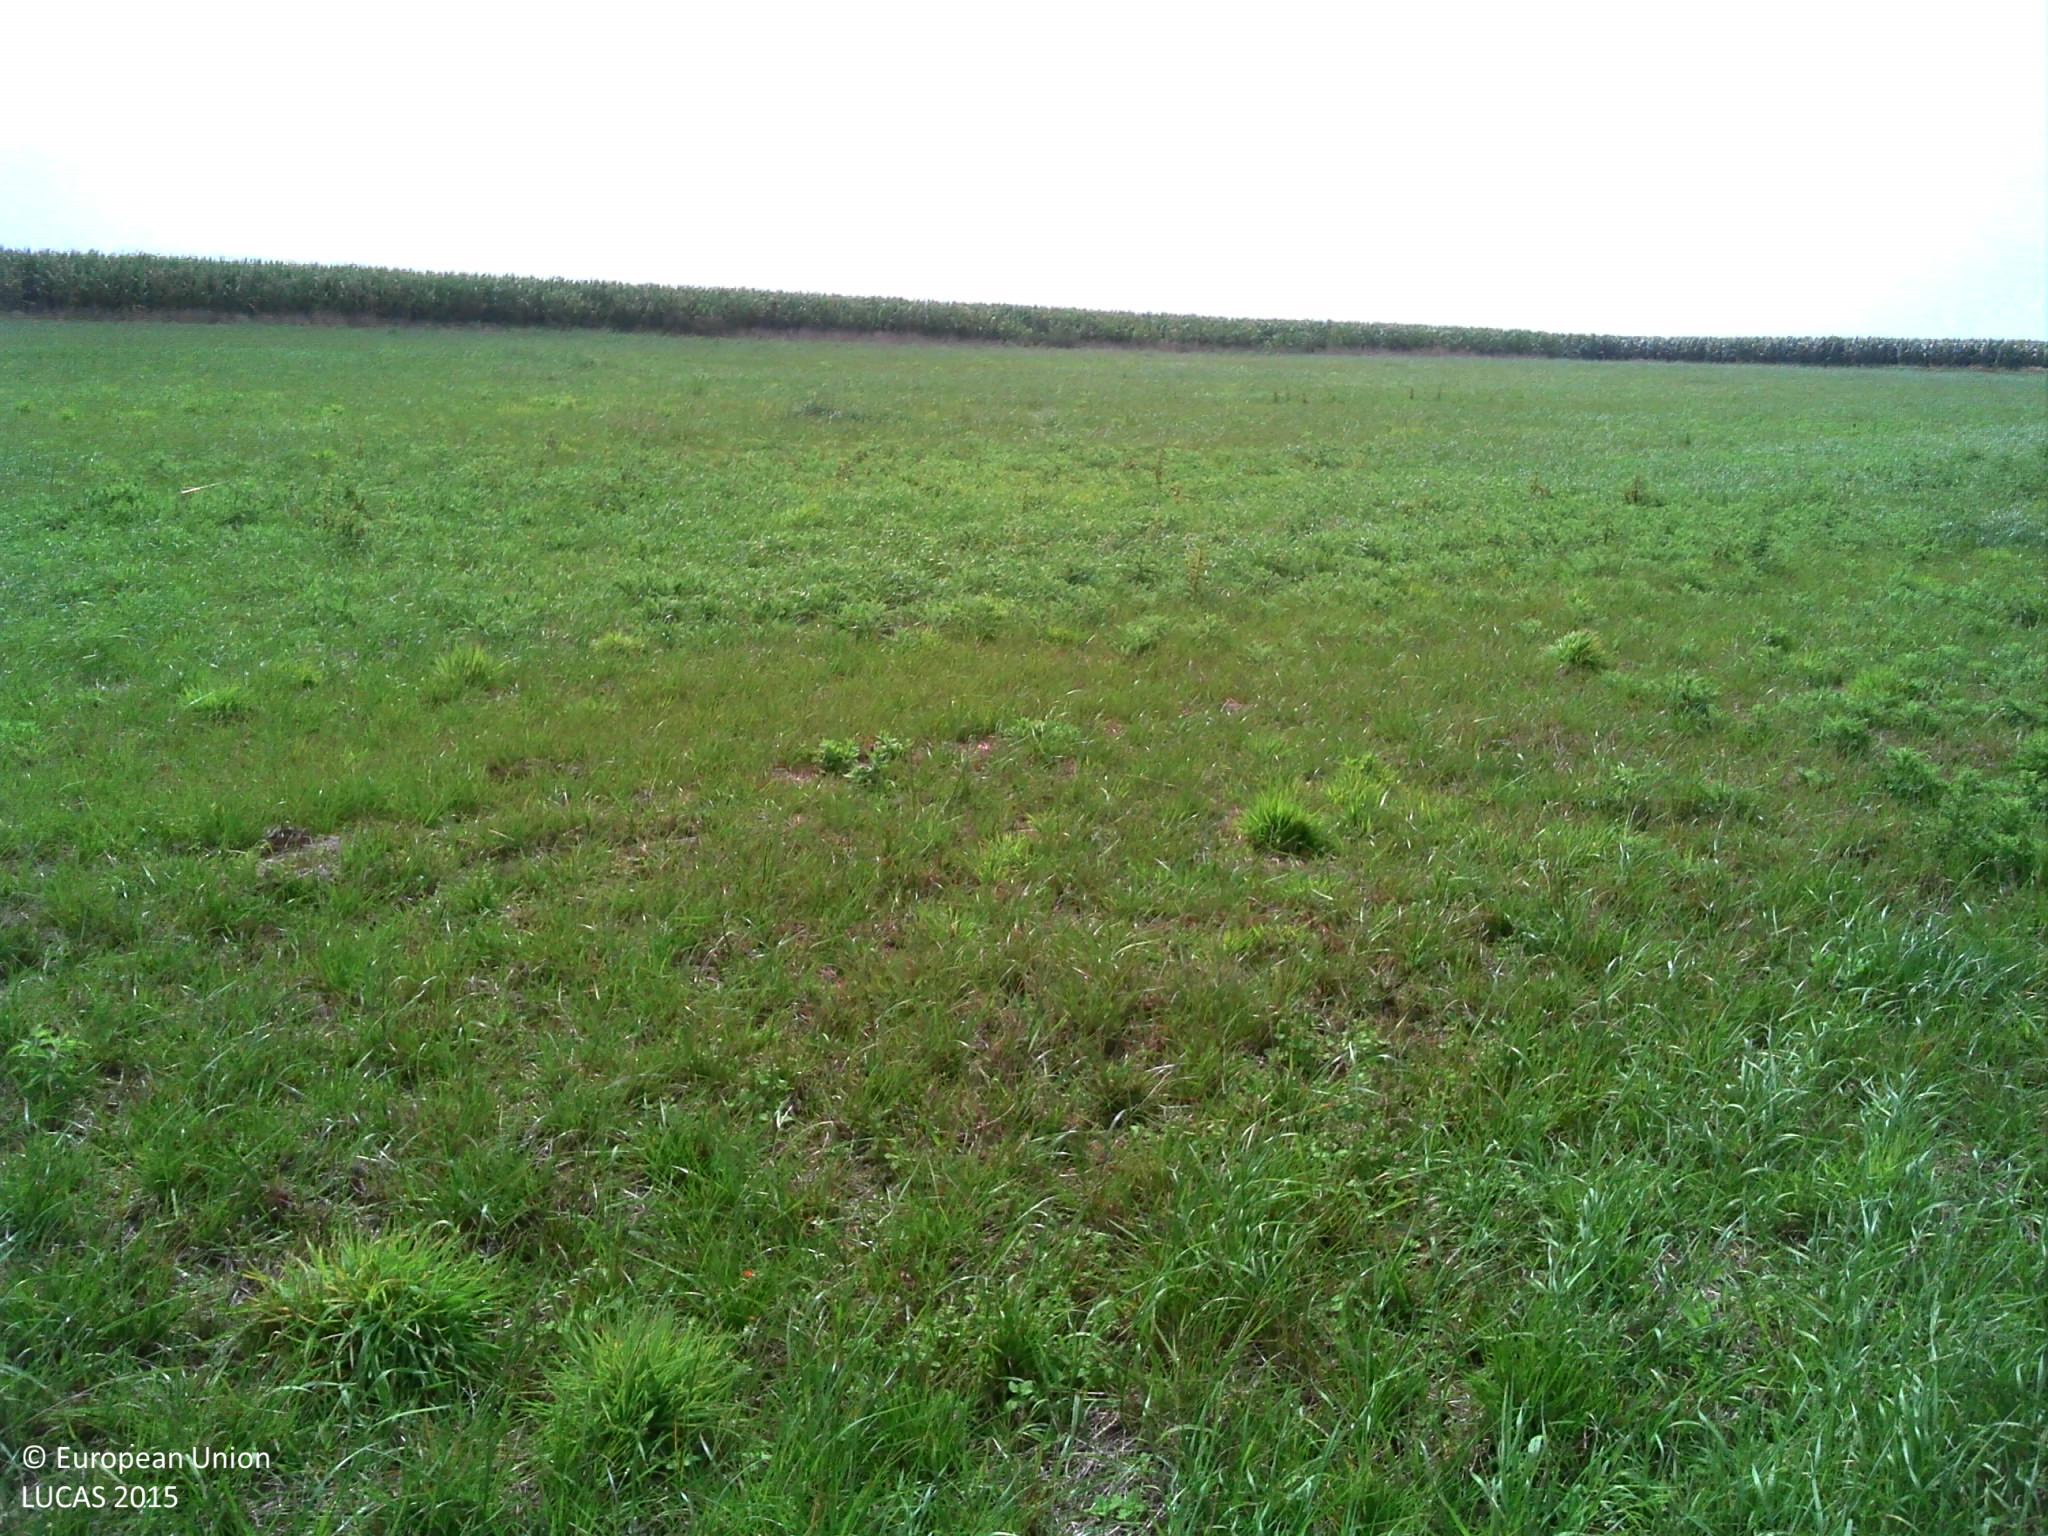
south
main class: Cropland
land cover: Temporary grasslands
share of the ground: > 75 %
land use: Agriculture (excluding fallow land and kitchen gardens)
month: August
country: FR
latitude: 50.6687
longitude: 1.5911
